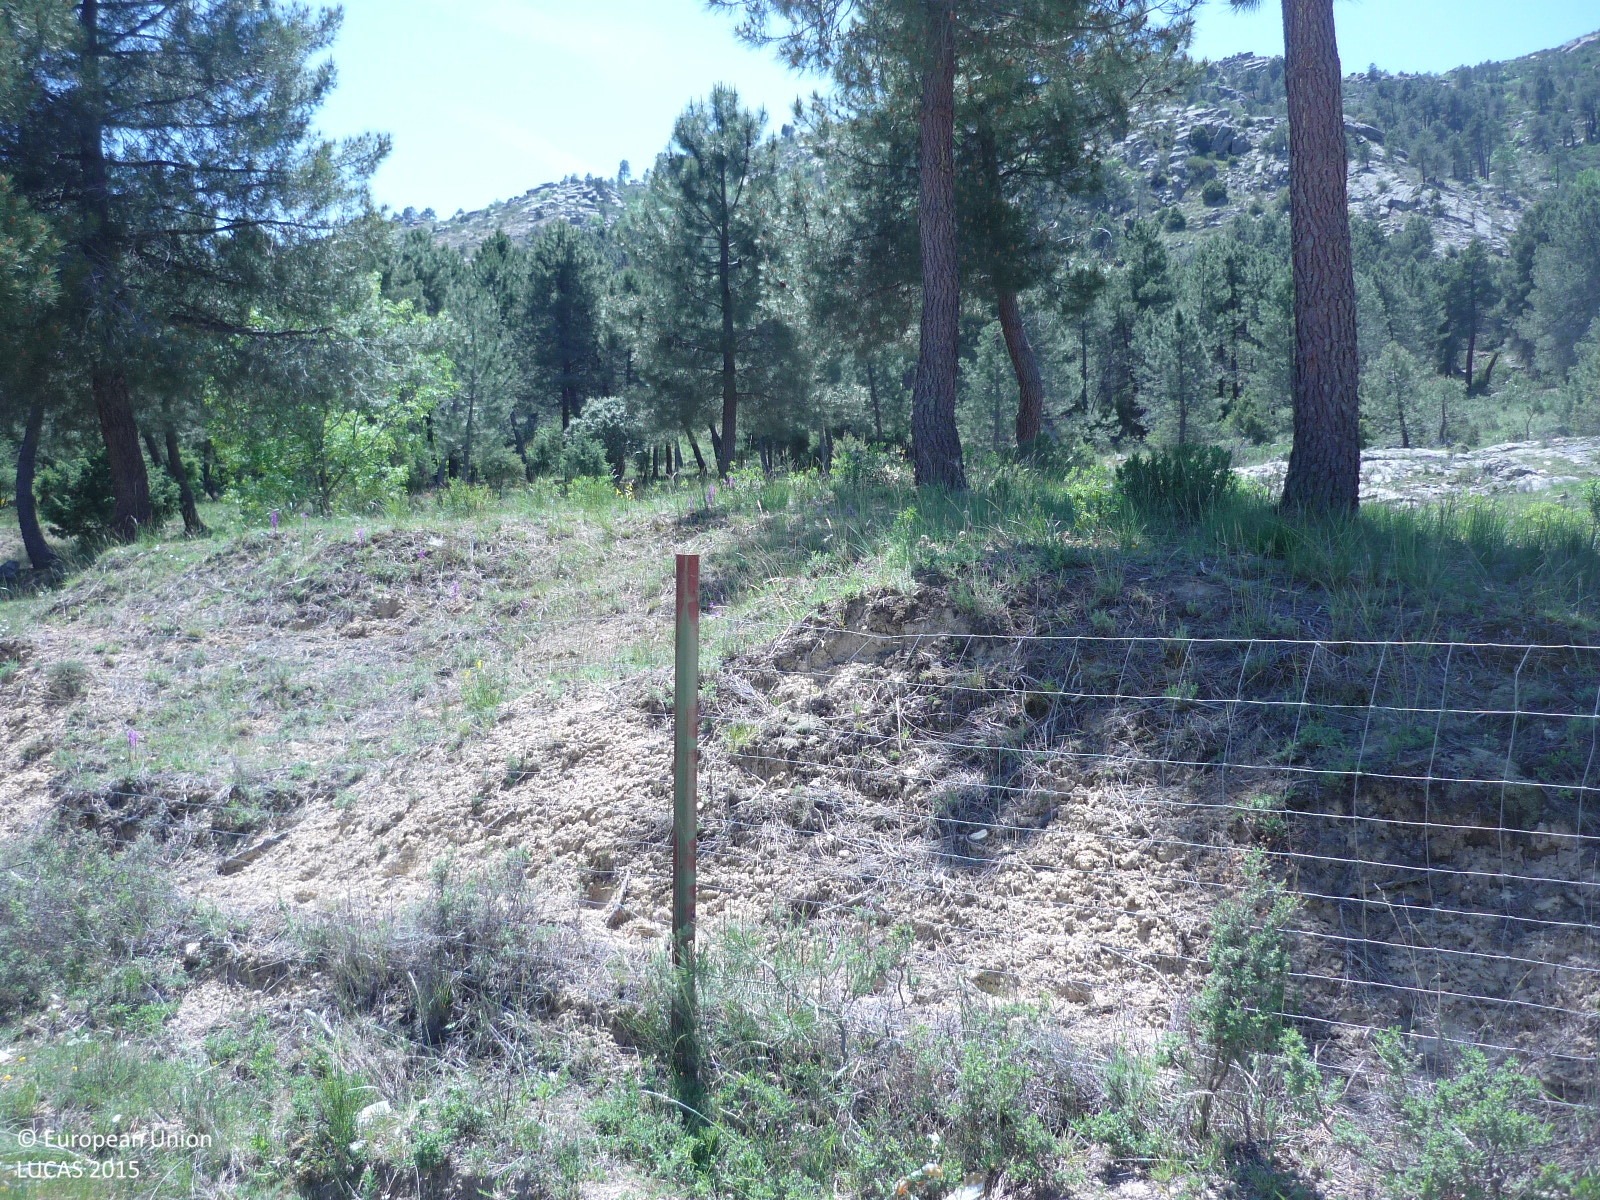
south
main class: Woodland
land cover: Broadleaved woodland
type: broadleaved evergreen forest
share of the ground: 25 - 50 %
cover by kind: herbaceous plants 60 %, broadleaved forest trees 40 %
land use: Forestry
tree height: > 5 m
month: May
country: ES
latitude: 40.9037
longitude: -3.6353
